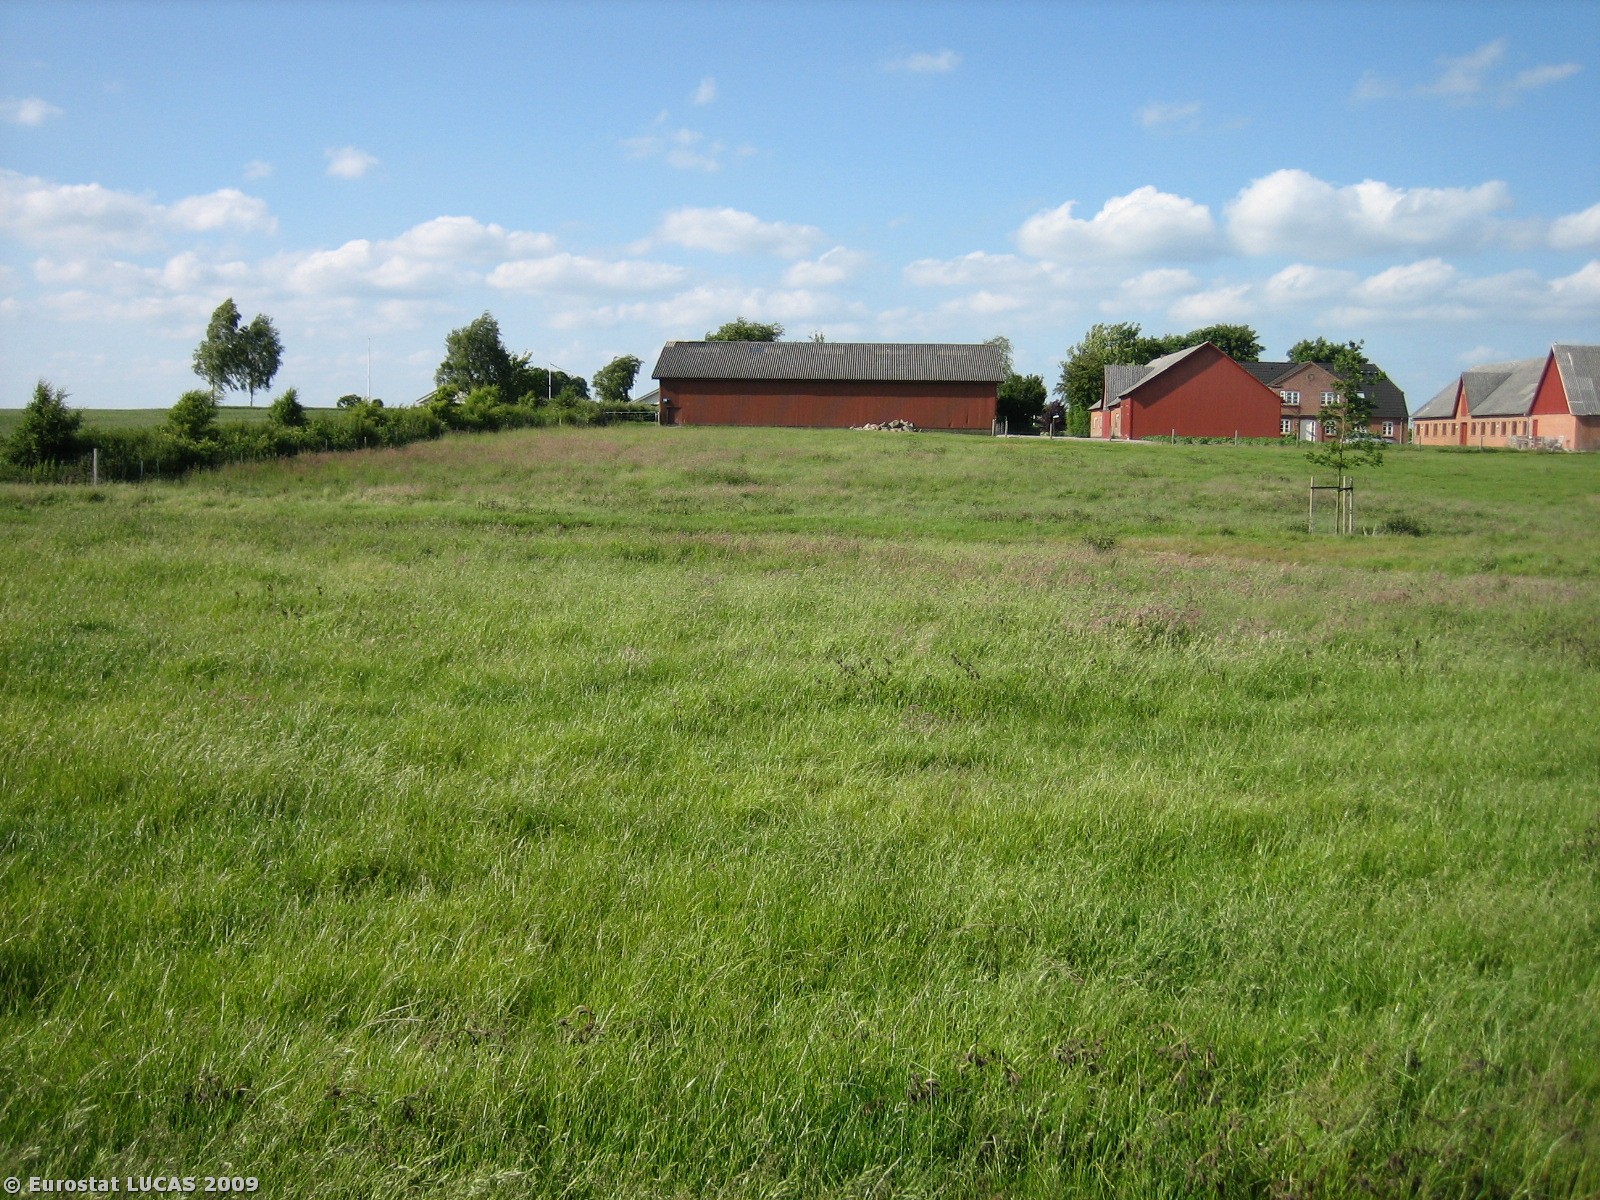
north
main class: Cropland
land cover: Common wheat
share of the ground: > 75 %
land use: Agriculture (excluding fallow land and kitchen gardens)
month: June
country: DK
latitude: 55.8102
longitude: 9.9203
